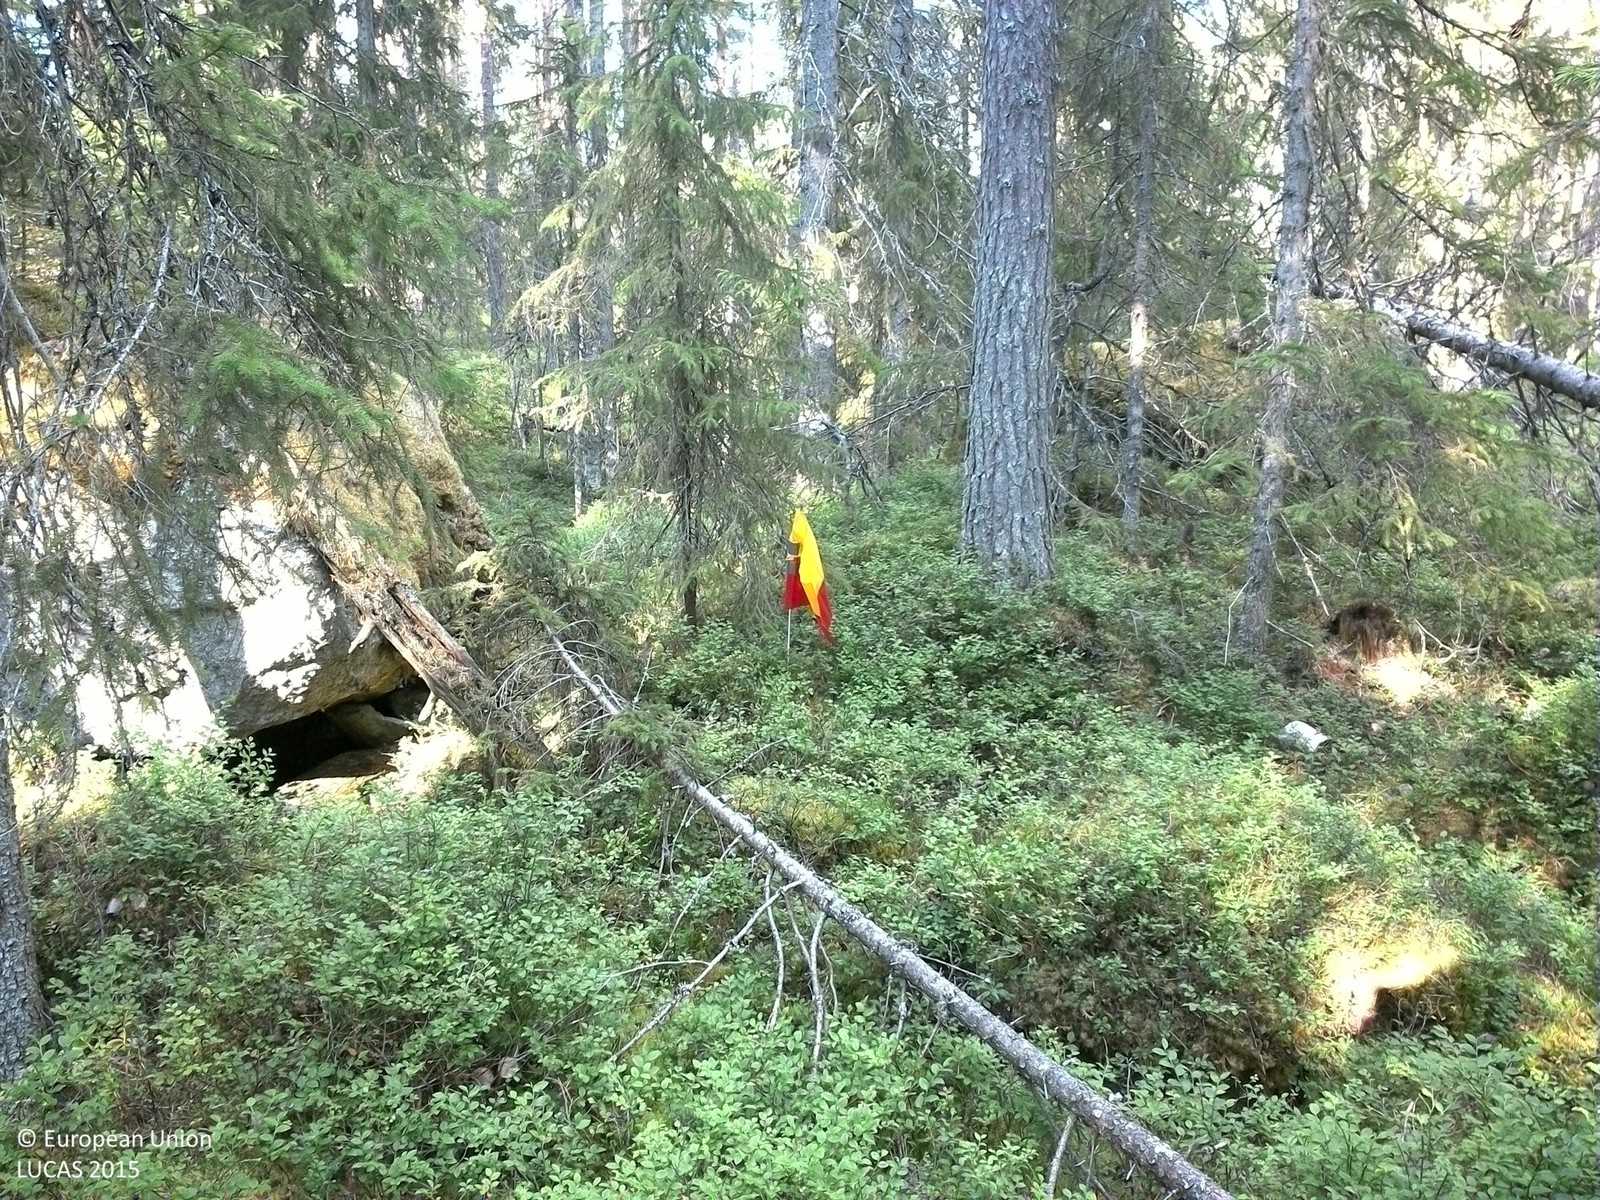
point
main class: Woodland
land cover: Pine dominated coniferous woodland
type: boreal forest
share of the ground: 50 - 75 %
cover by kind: coniferous forest trees 50 %, shrubs 35 %, lichens and mosses 15 %
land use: Forestry
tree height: > 5 m
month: August
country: SE
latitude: 63.6361
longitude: 16.3714
